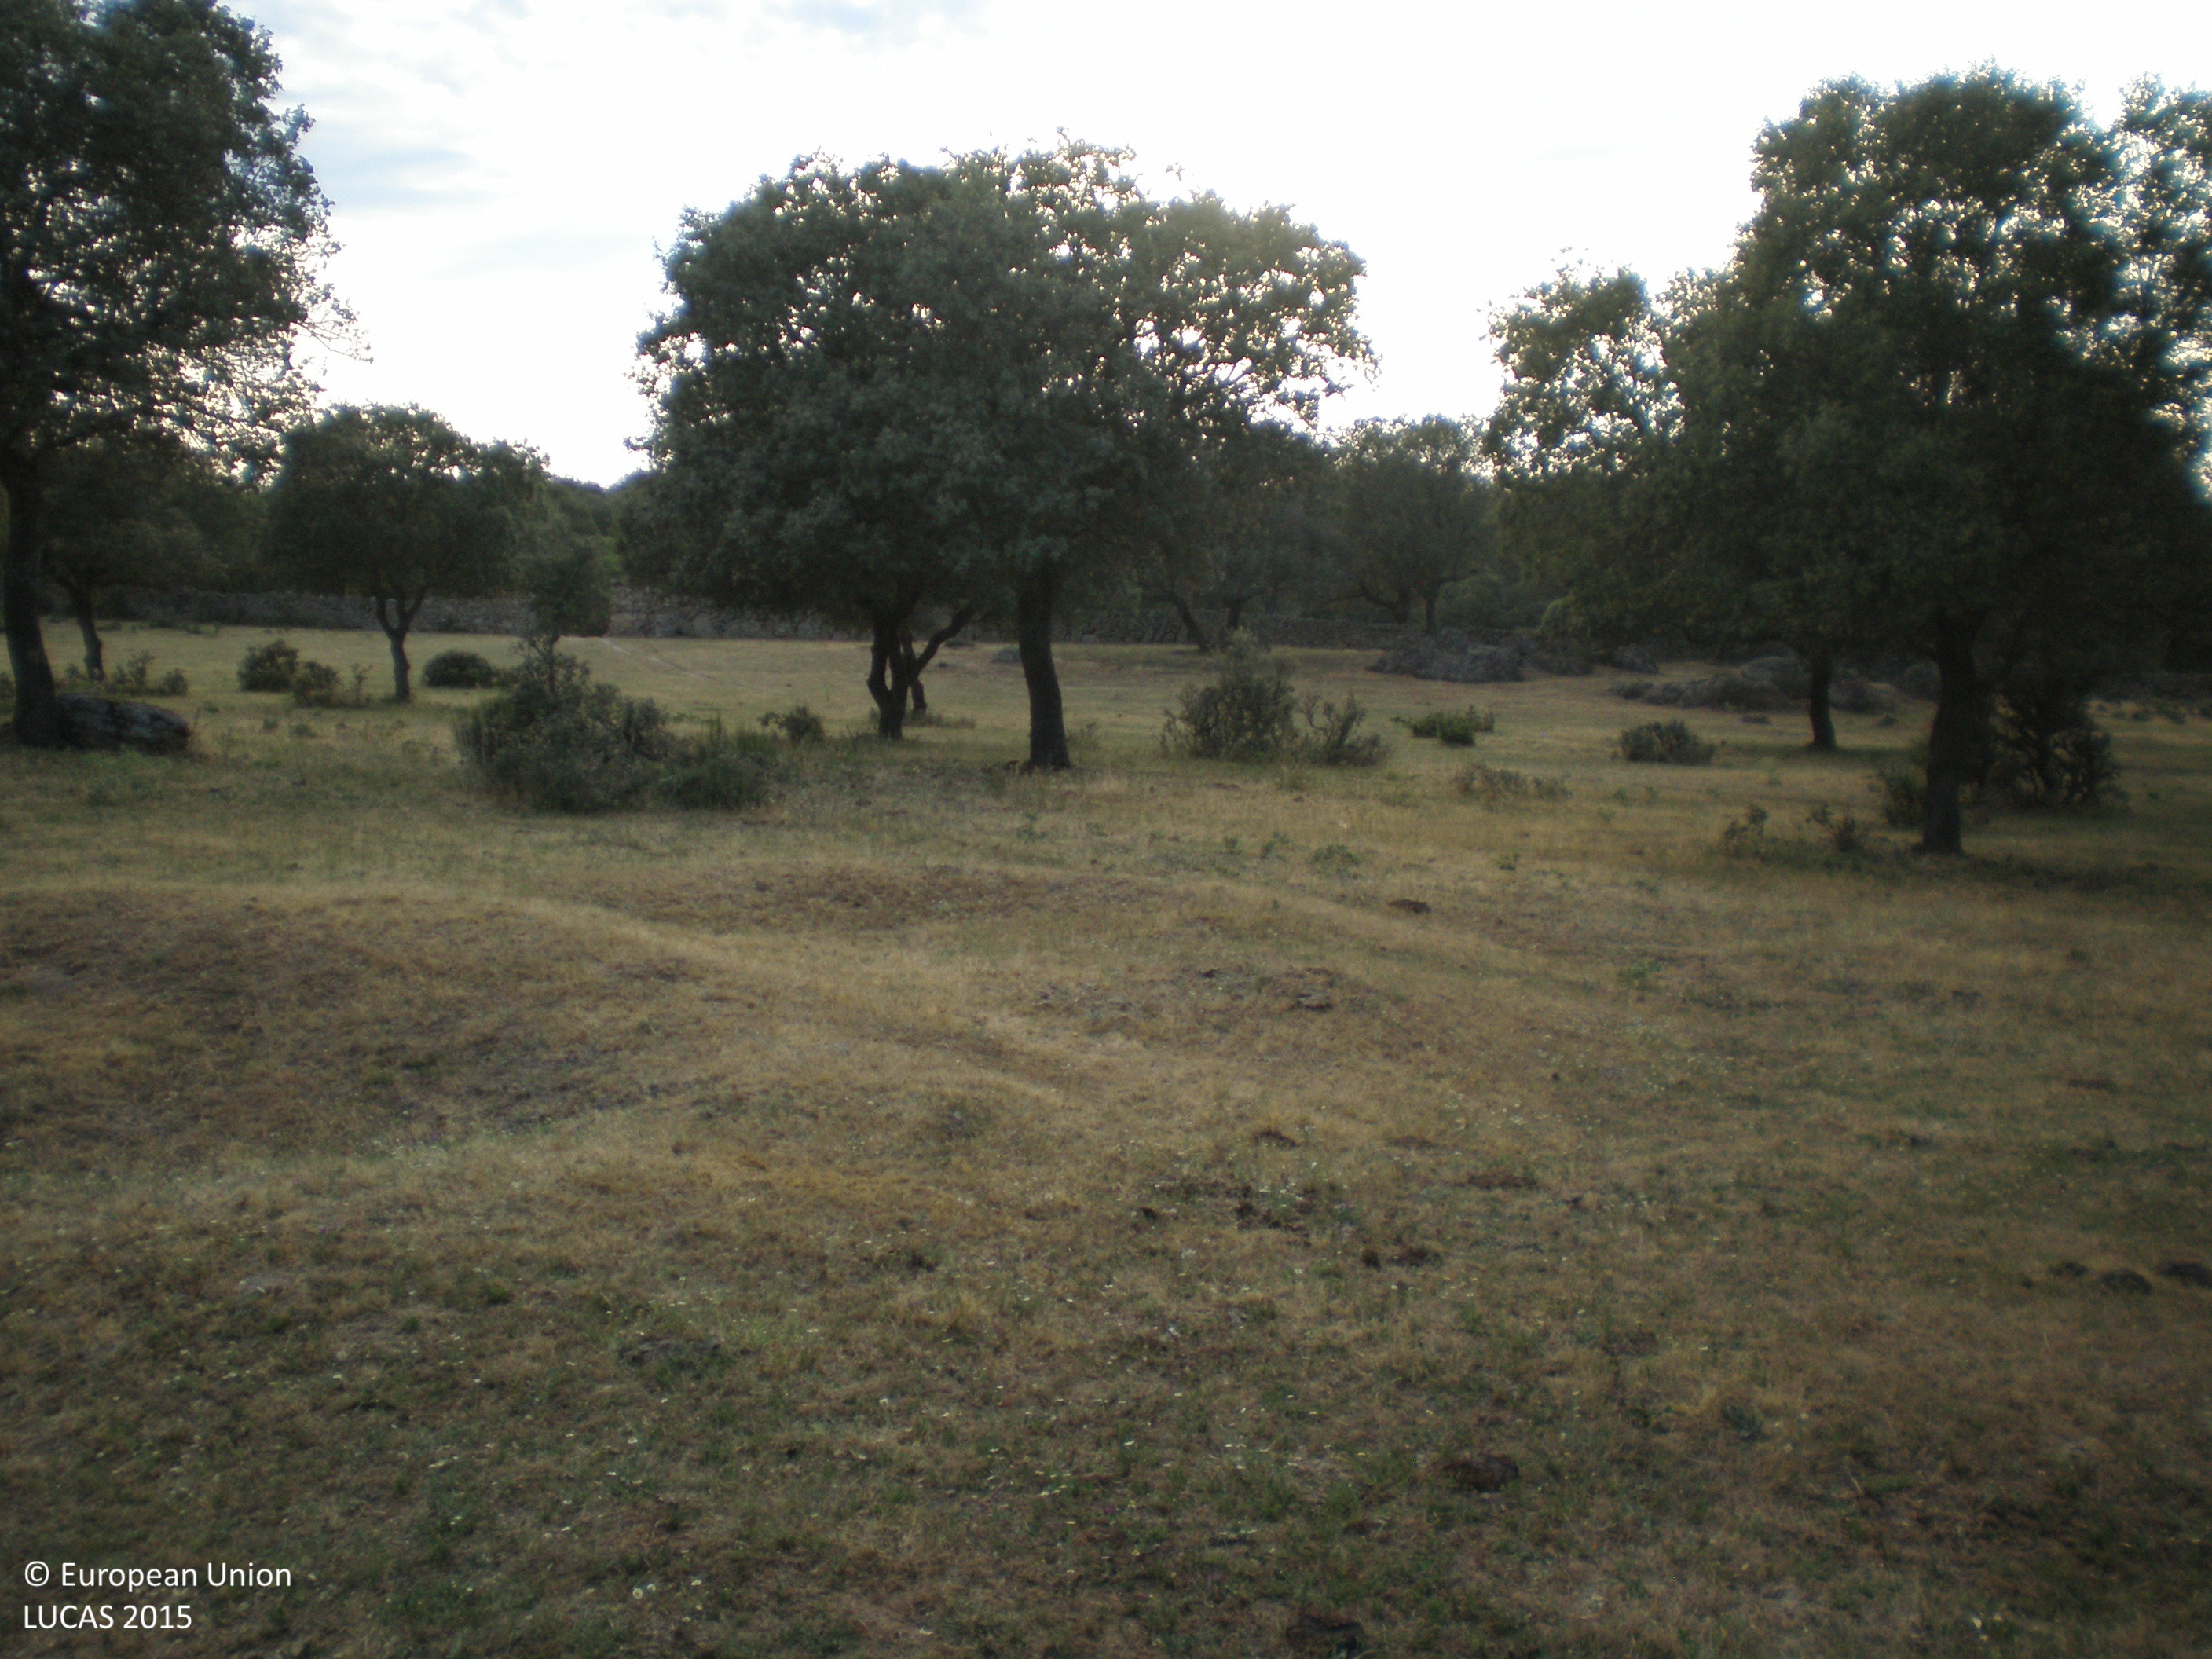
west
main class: Grassland
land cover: Grassland with sparse tree/shrub cover
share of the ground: > 75 %
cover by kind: herbaceous plants 95 %, broadleaved forest trees 5 %
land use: Agriculture (excluding fallow land and kitchen gardens)
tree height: < 5 m
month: July
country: ES
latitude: 40.5160
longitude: -5.6137
